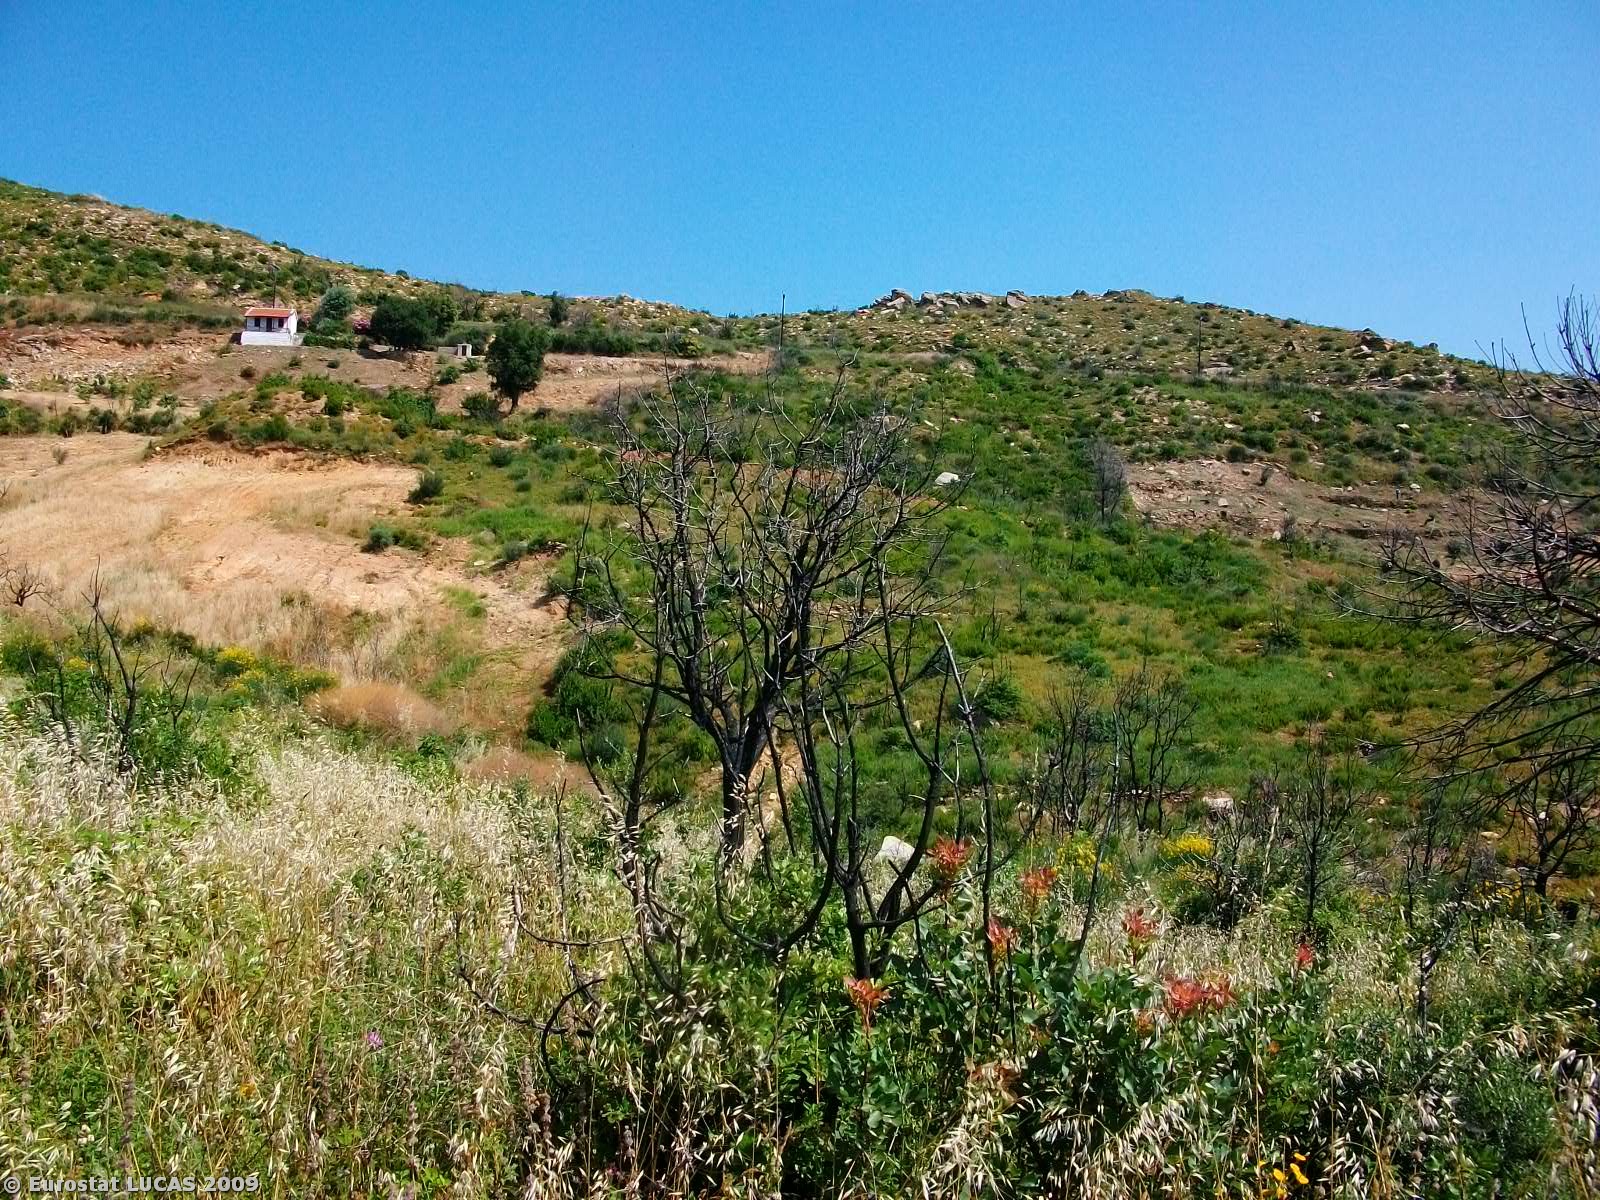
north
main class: Grassland
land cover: Grassland with sparse tree/shrub cover
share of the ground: > 75 %
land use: Unused
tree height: < 5 m
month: June
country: GR
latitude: 39.2884
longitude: 23.2689
